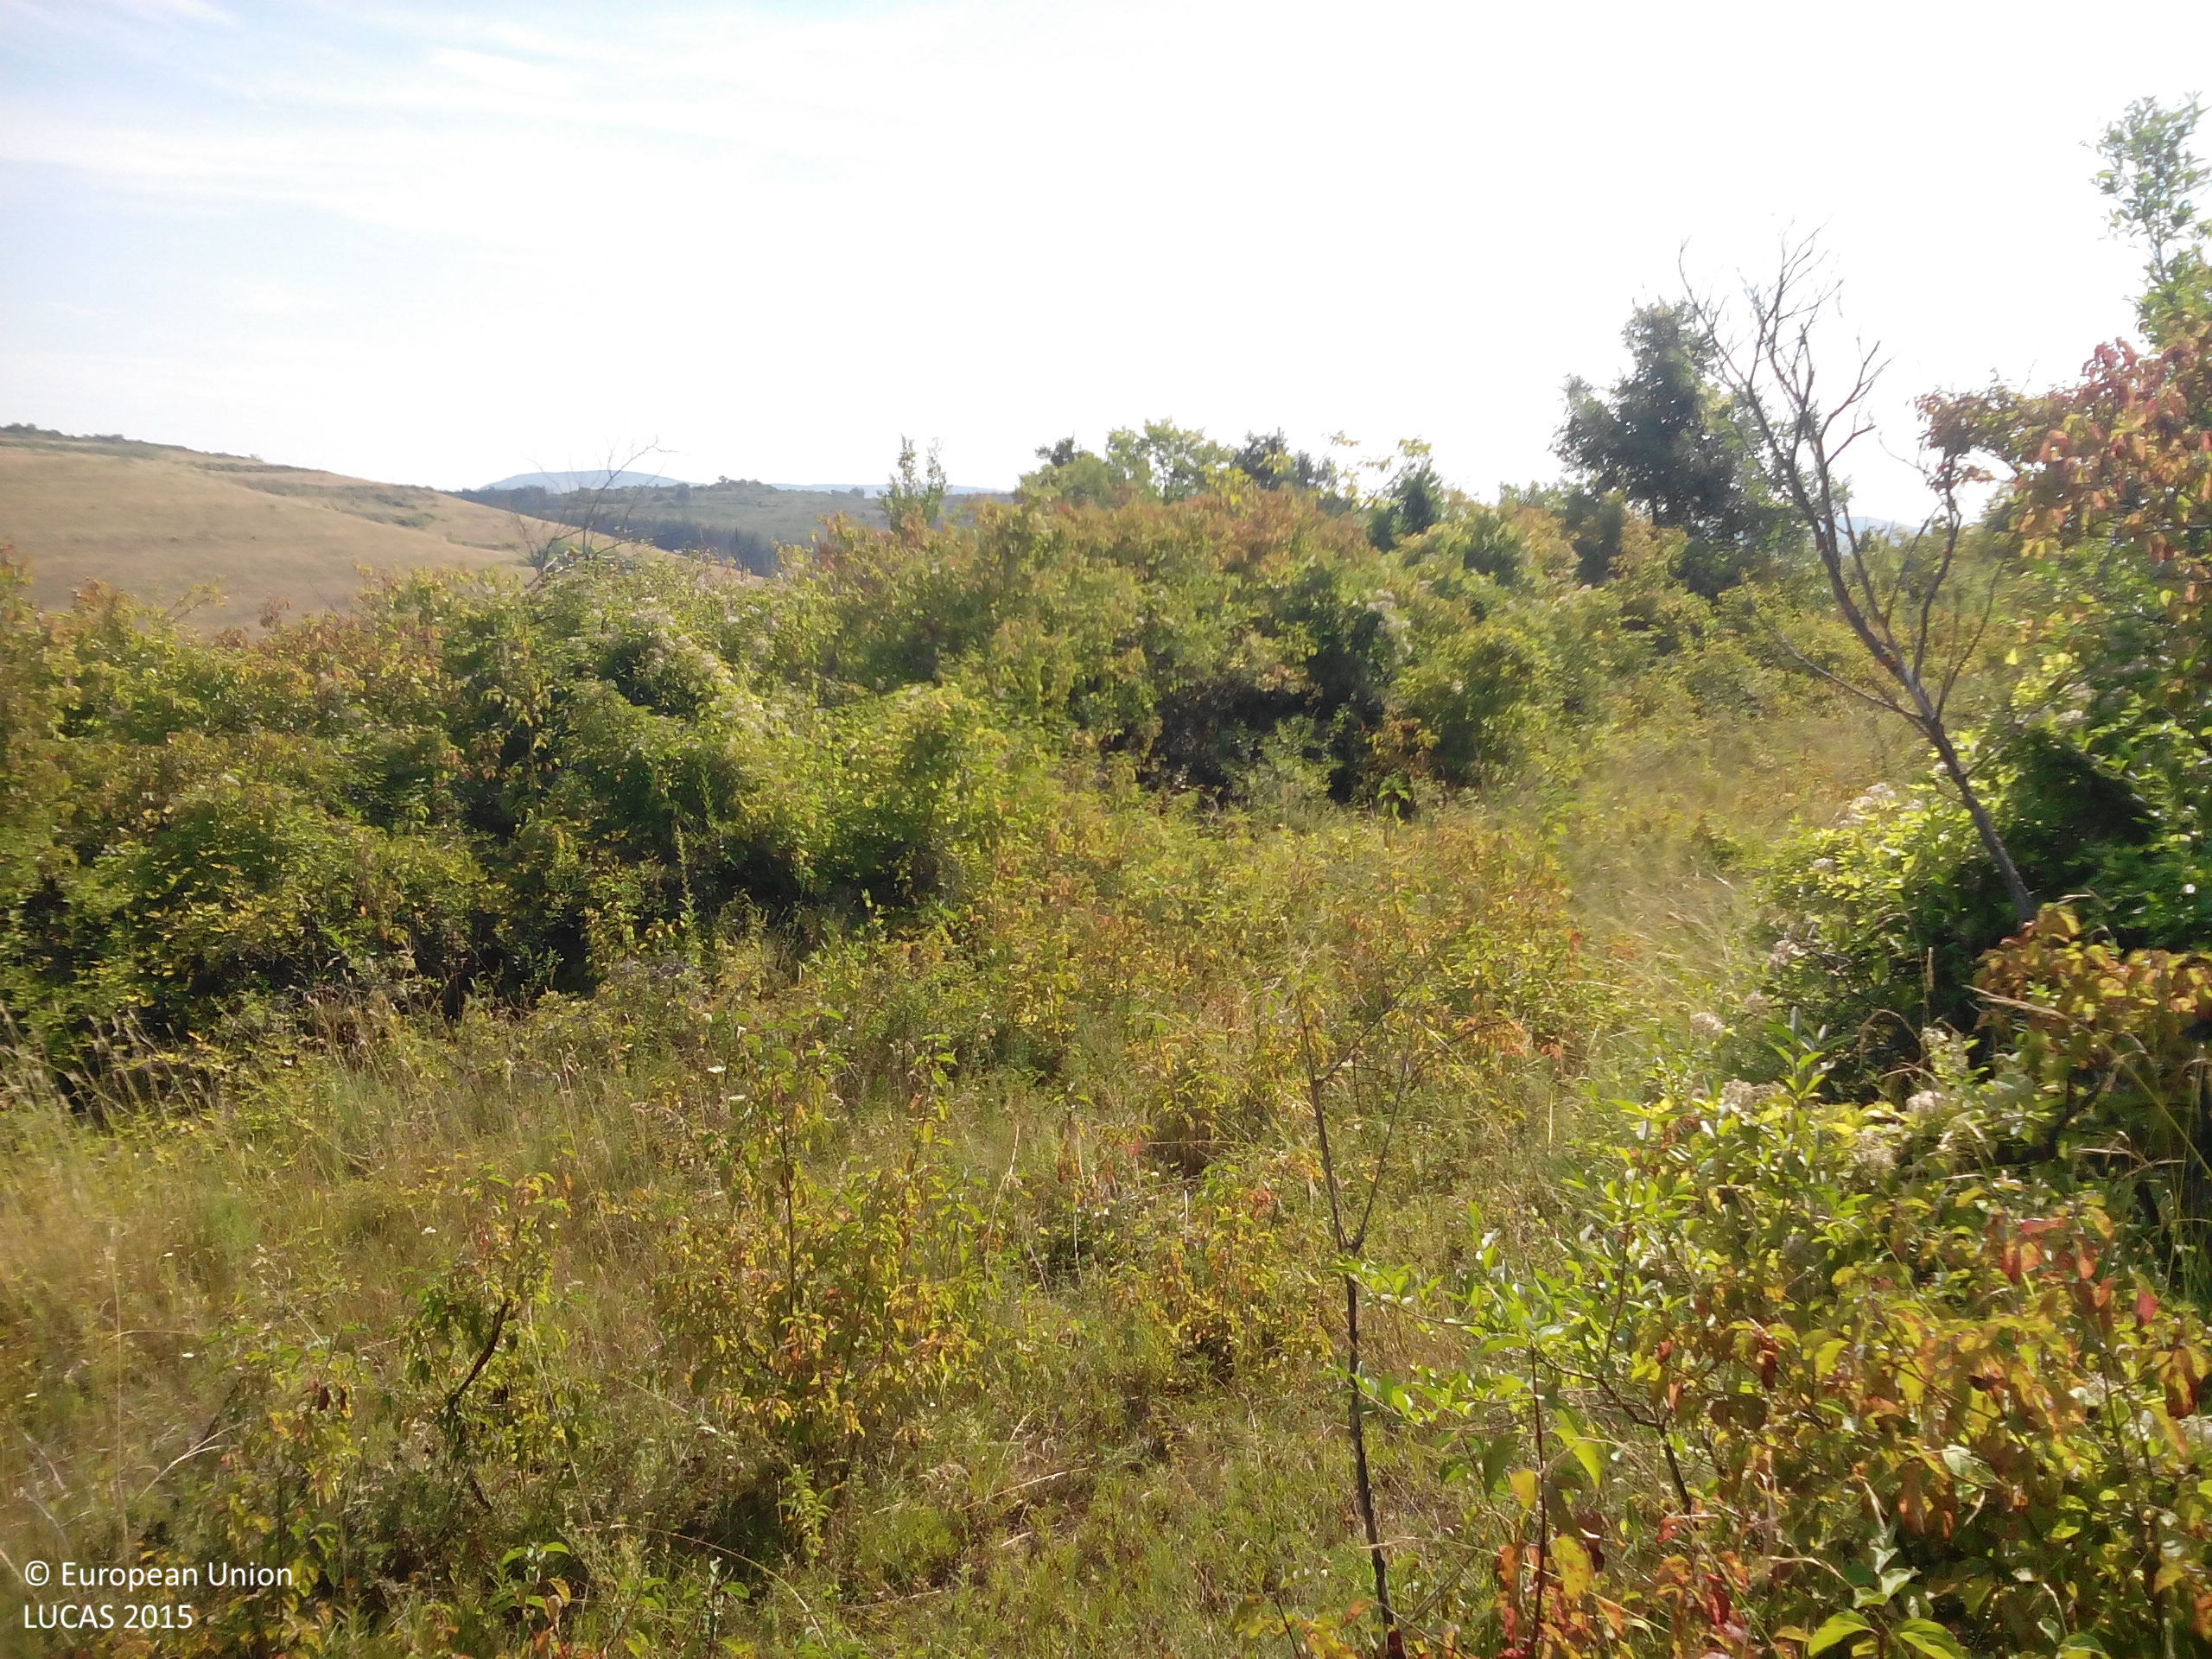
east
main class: Woodland
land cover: Broadleaved woodland
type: mesophytic deciduous forest
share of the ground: 25 - 50 %
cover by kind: shrubs 65 %, broadleaved forest trees 35 %
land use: Semi-natural and natural areas not in use
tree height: > 5 m
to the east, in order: Broadleaved woodland; Shrubland with sparse tree cover; Rivers and streams; Shrubland with sparse tree cover; Ditches and canals; Shrubland with sparse tree cover
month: August
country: BG
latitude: 43.1517
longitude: 23.7815
